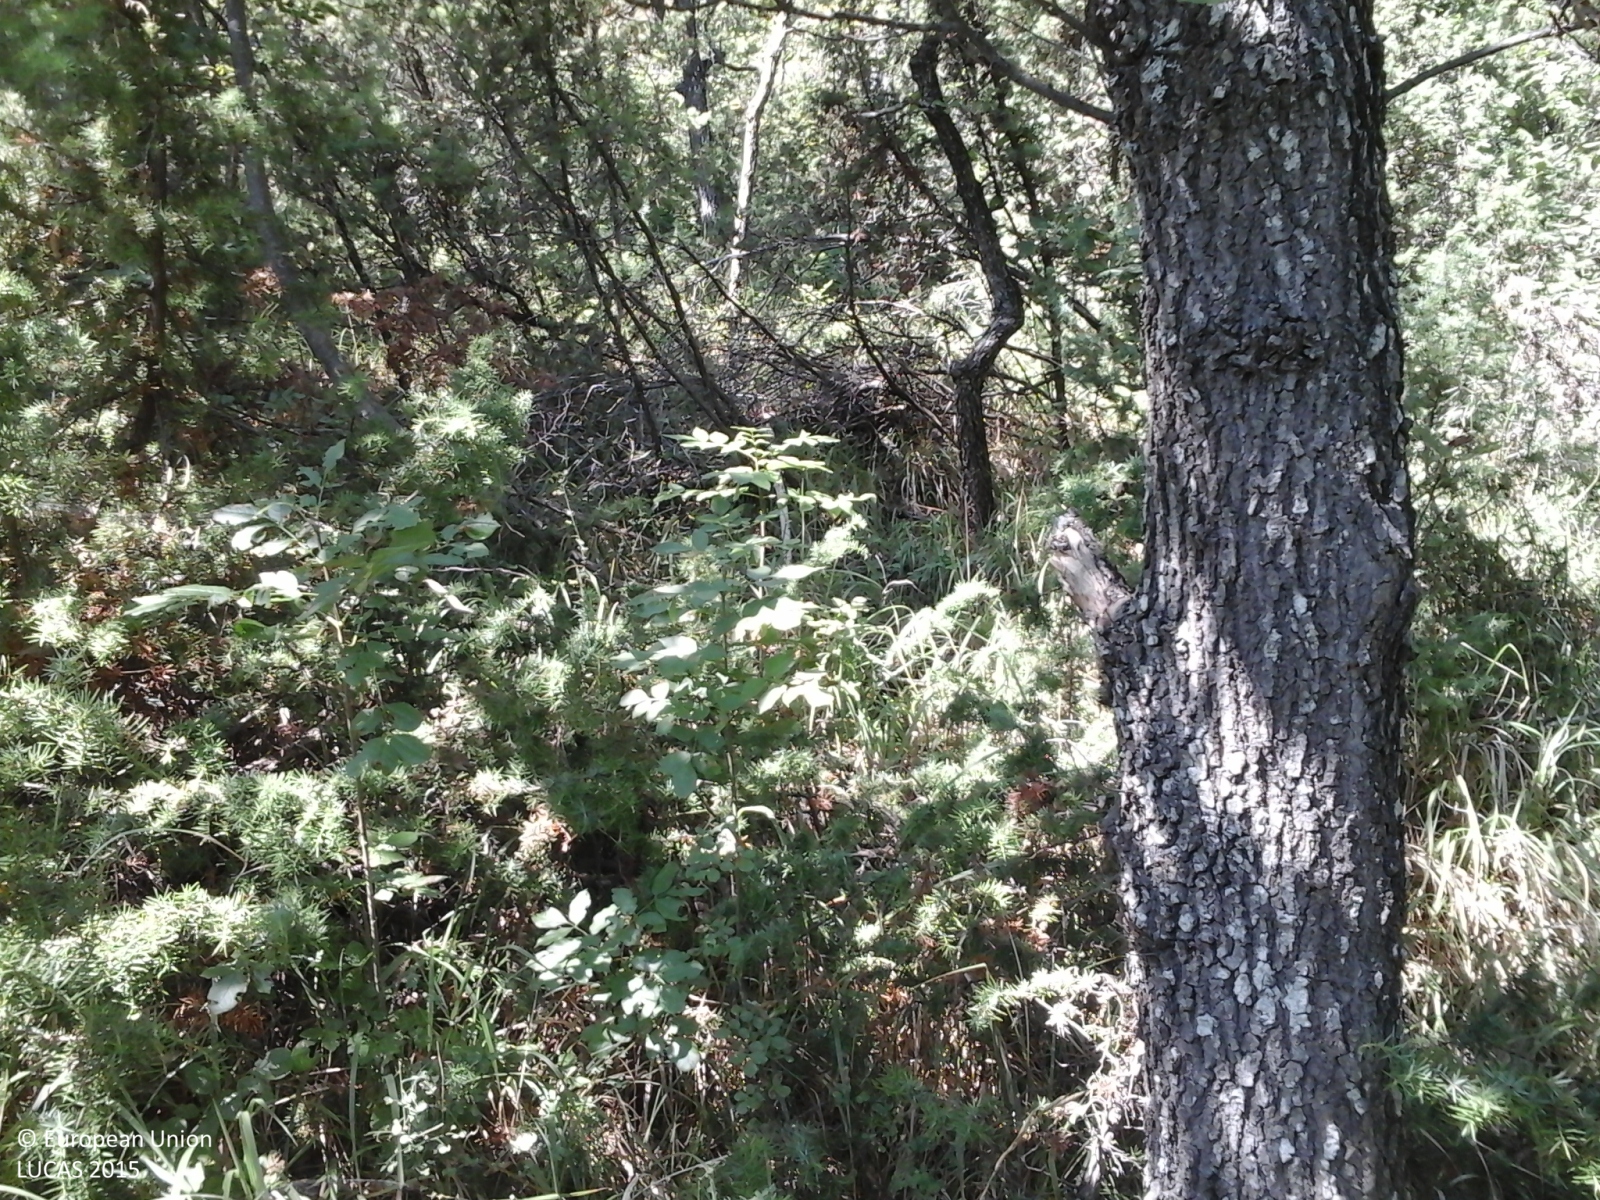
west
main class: Woodland
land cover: Broadleaved woodland
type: thermophilous deciduous forest
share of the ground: > 75 %
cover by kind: broadleaved forest trees 100 %
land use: Forestry
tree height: > 5 m
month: August
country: IT
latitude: 44.8156
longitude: 9.1040
